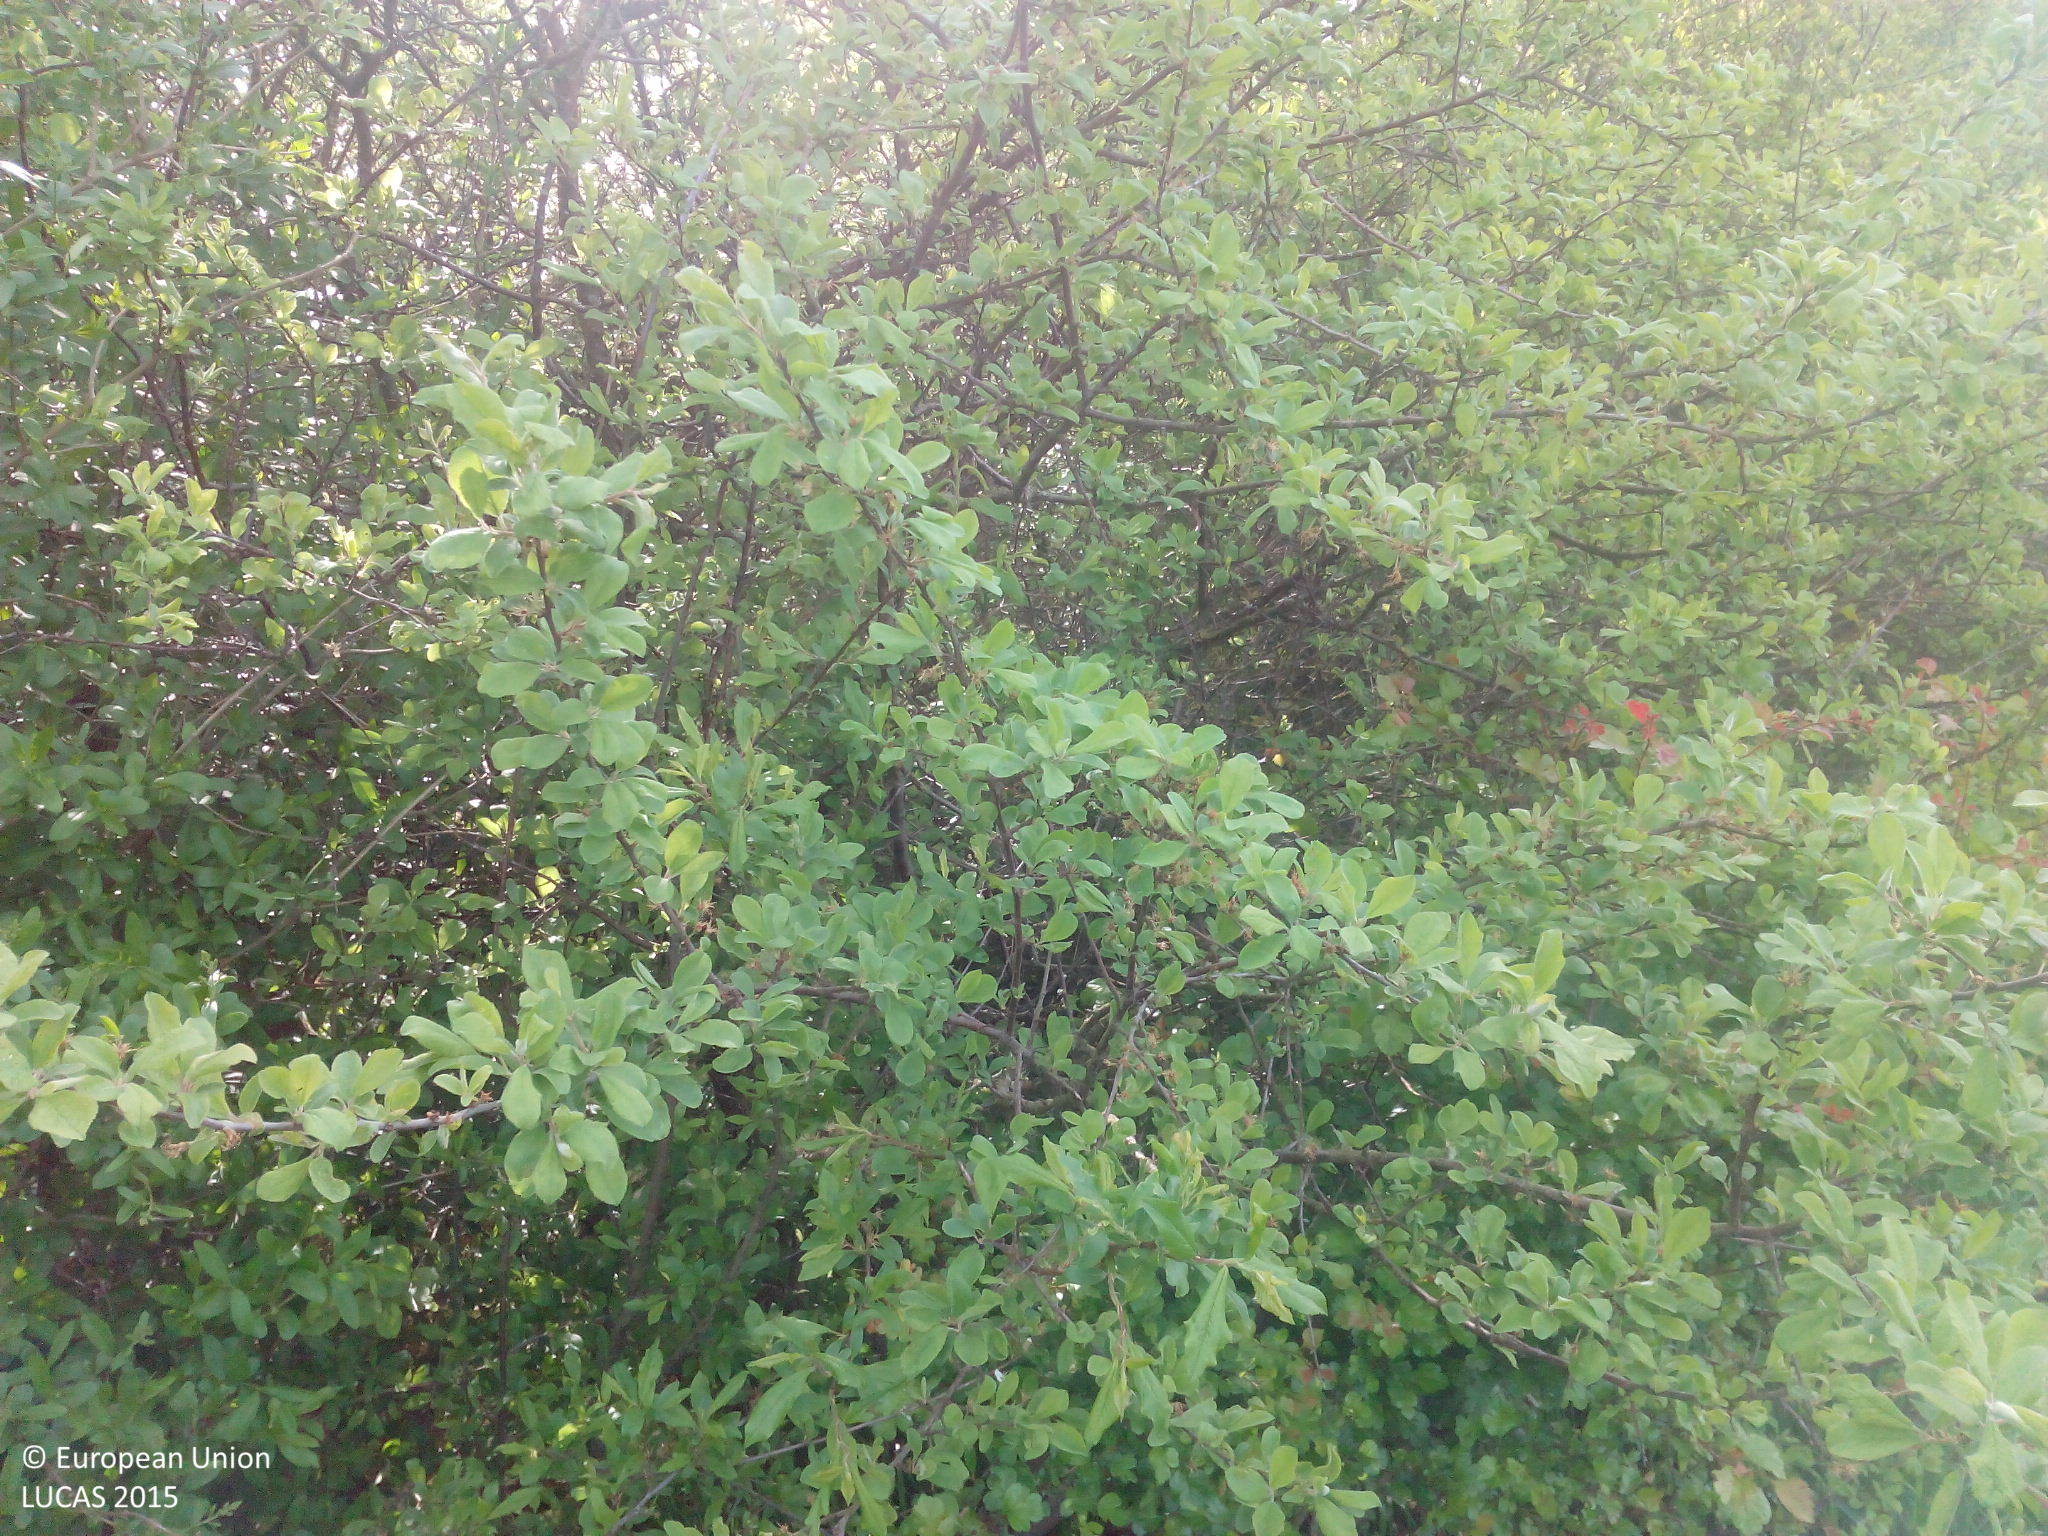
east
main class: Shrubland
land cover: Shrubland with sparse tree cover
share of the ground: > 75 %
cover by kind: shrubs 95 %, broadleaved forest trees 5 %
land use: Semi-natural and natural areas not in use
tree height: < 5 m
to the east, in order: Shrubland with sparse tree cover; Tracks; Shrubland with sparse tree cover; Electric lines; Shrubland with sparse tree cover; Grassland without tree/shrub cover; Shrubland with sparse tree cover; Grassland without tree/shrub cover; Broadleaved woodland; Tracks; Lines of trees; Grass margins; Maize; Grass margins; Barley; Other bare soil
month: May
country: DE
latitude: 49.9227
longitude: 11.4900
